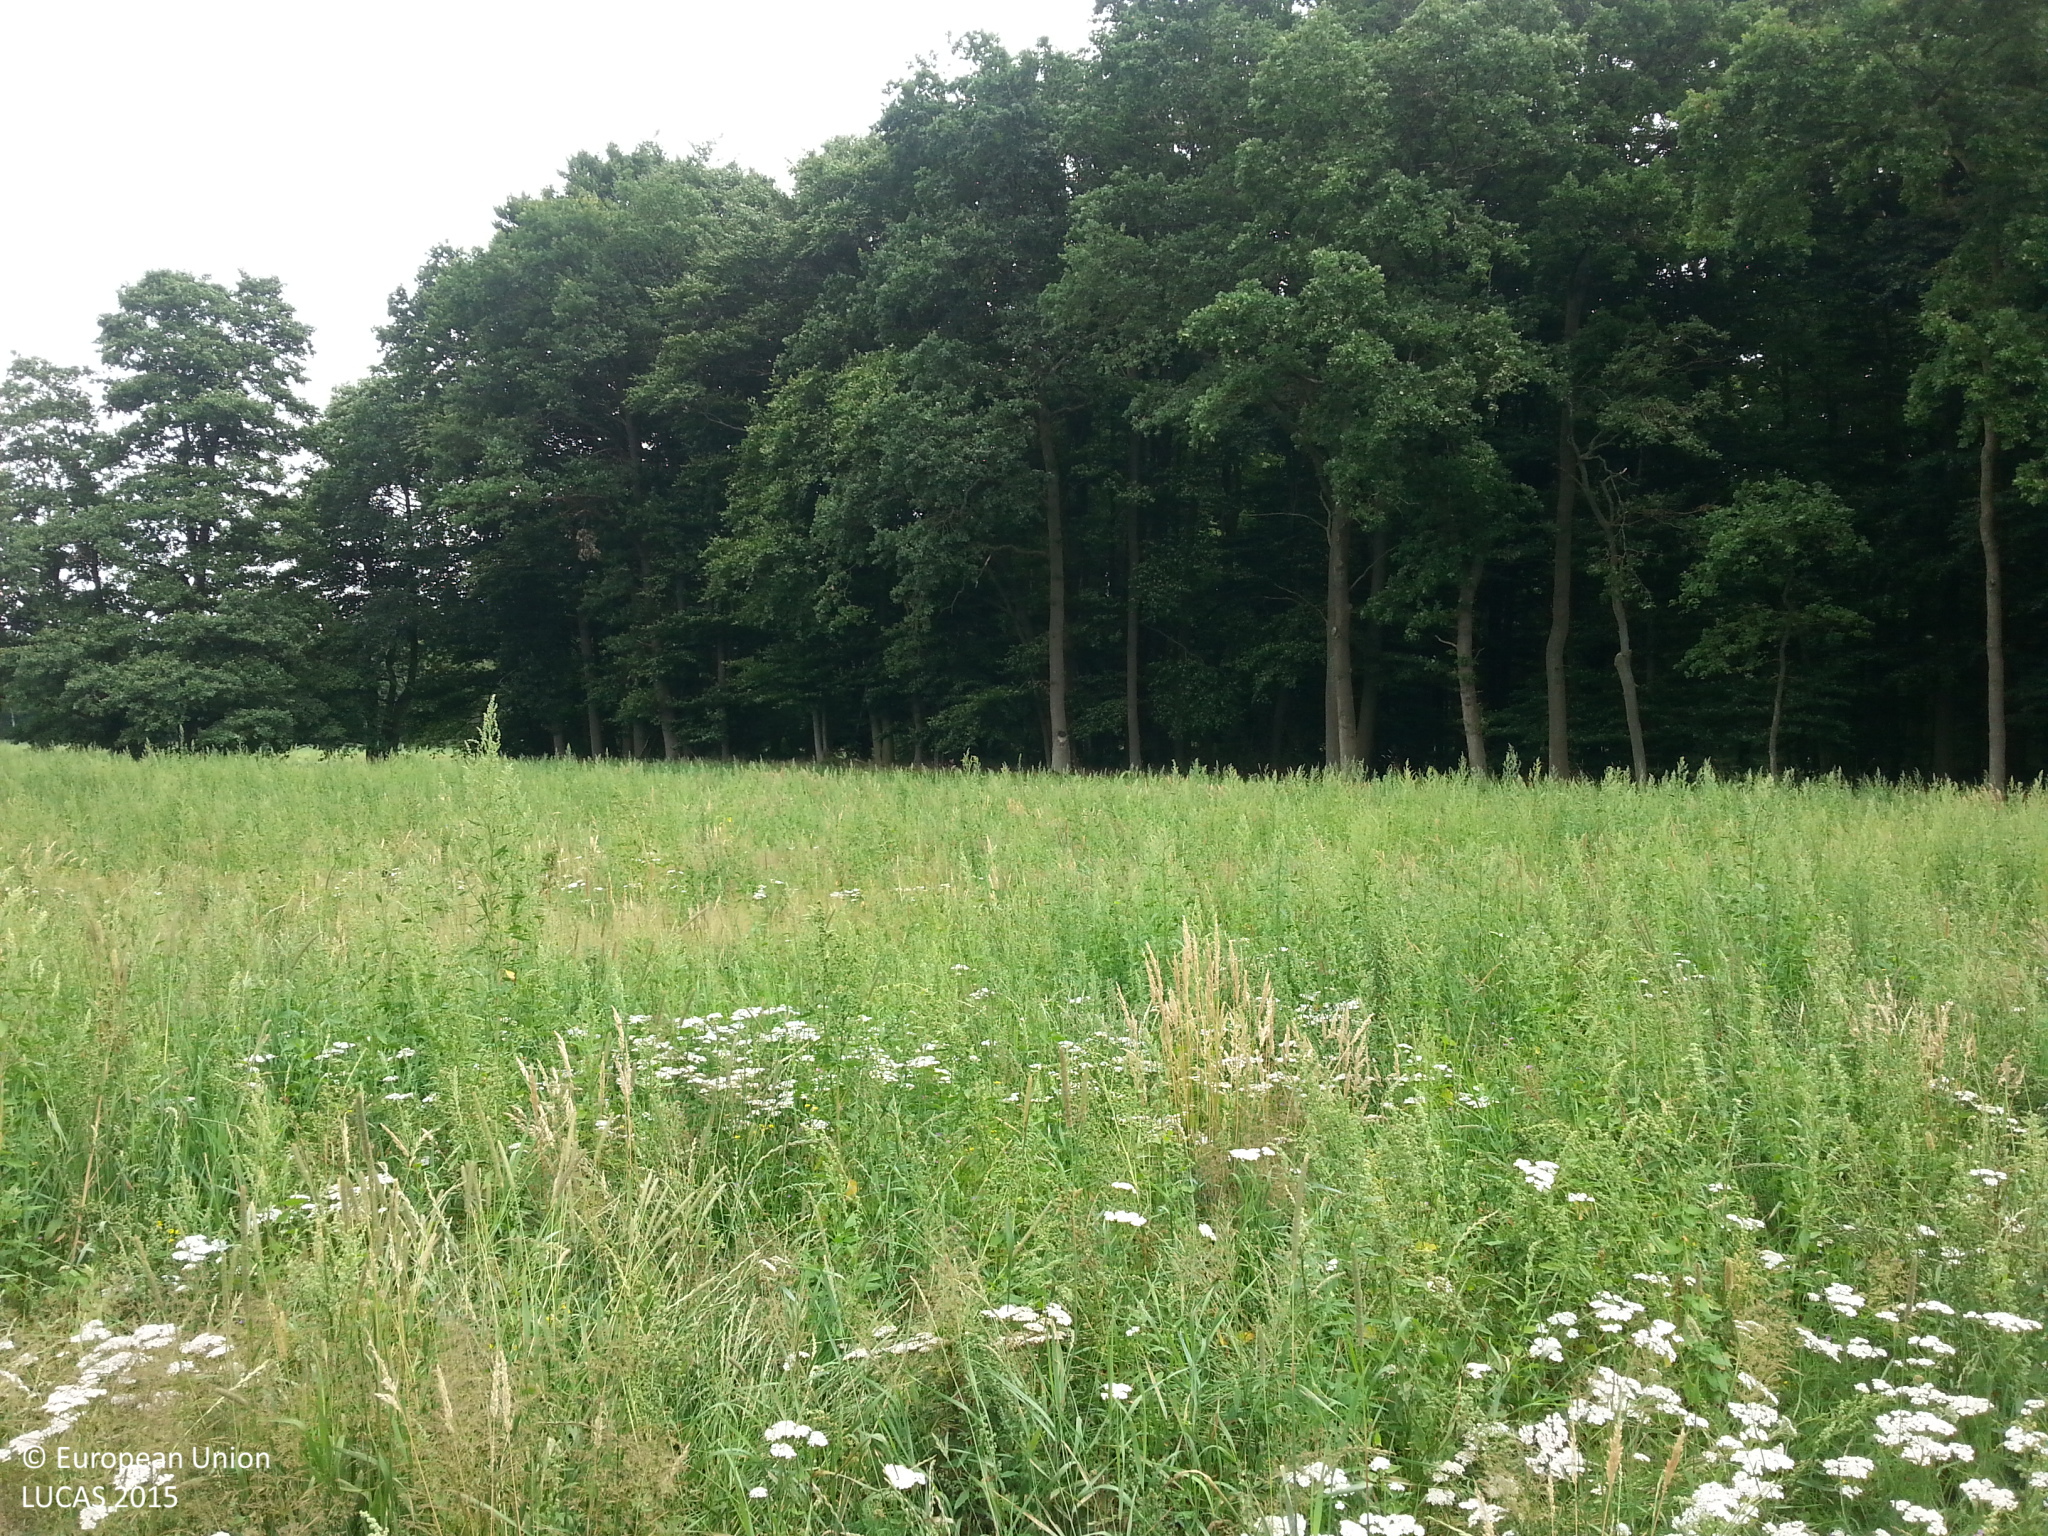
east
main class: Grassland
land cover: Grassland without tree/shrub cover
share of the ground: > 75 %
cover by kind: herbaceous plants 100 %
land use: Agriculture (excluding fallow land and kitchen gardens)
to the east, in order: Grassland without tree/shrub cover; Ditches and canals; Broadleaved woodland
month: July
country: DE
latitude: 53.2352
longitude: 11.0932
